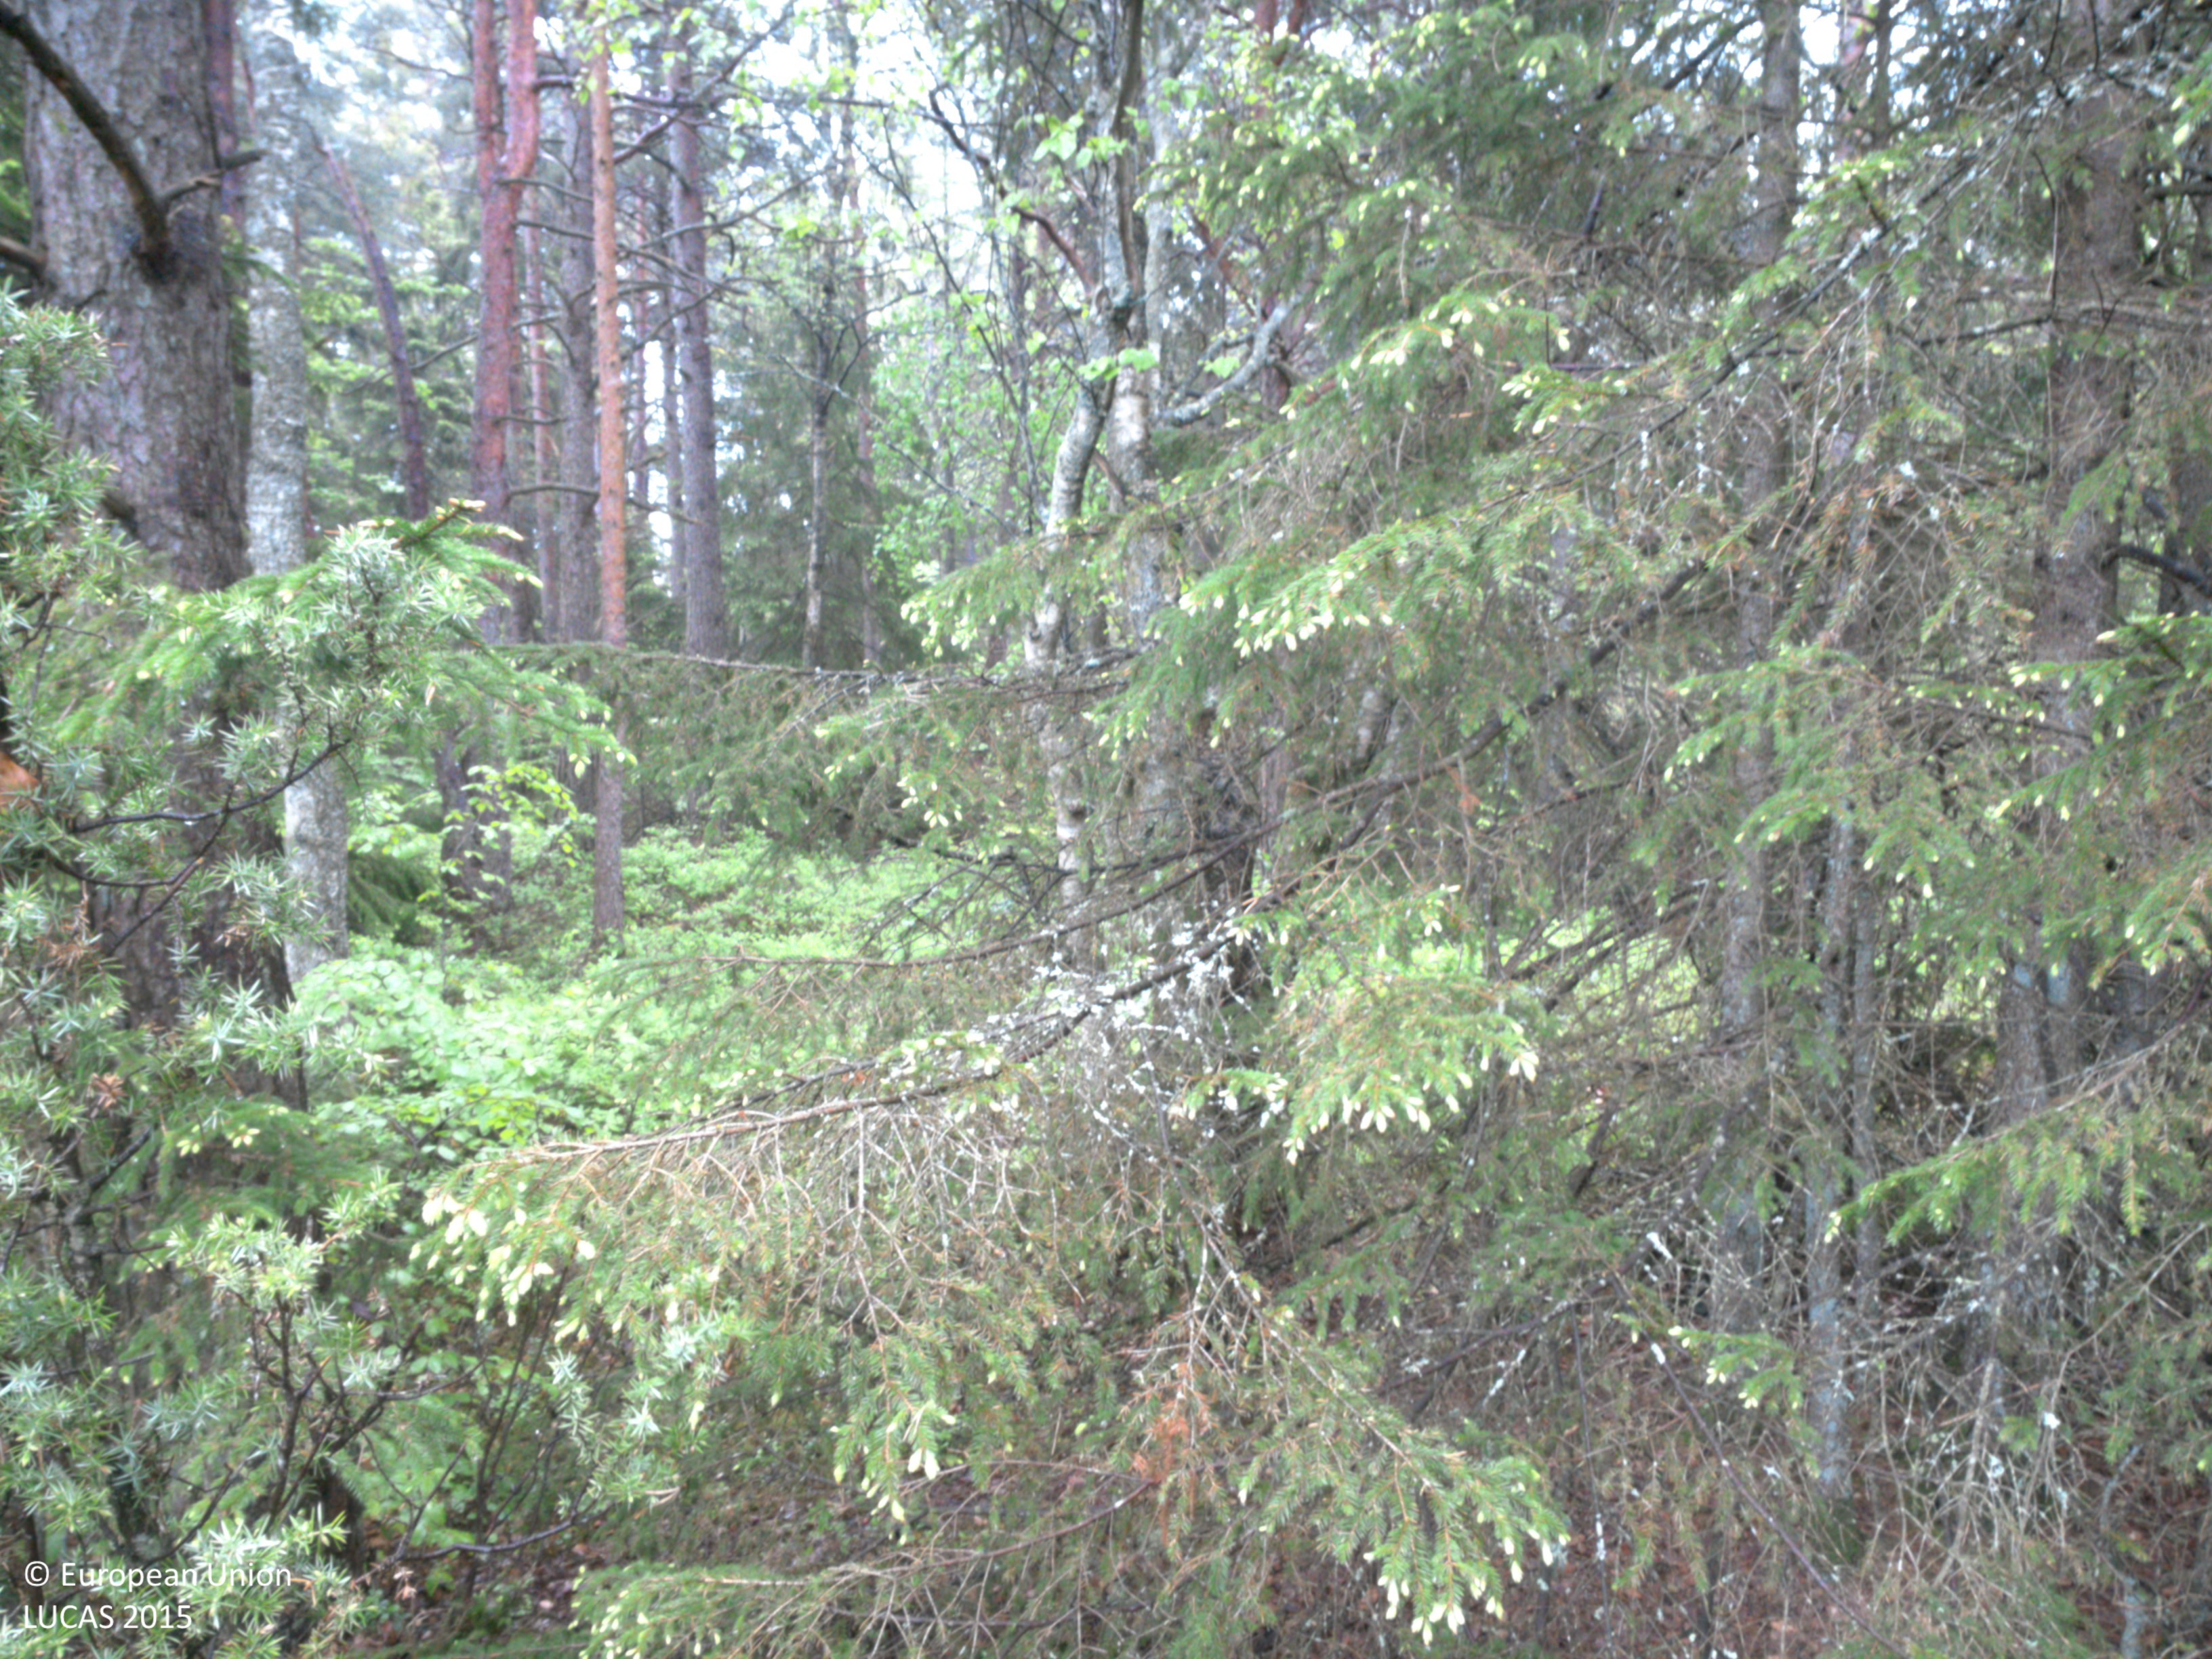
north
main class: Woodland
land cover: Spruce dominated mixed woodland
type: boreal forest
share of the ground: > 75 %
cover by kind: coniferous forest trees 60 %, broadleaved forest trees 30 %, herbaceous plants 10 %
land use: Forestry
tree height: > 5 m
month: May
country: SE
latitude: 58.3536
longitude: 11.6201
